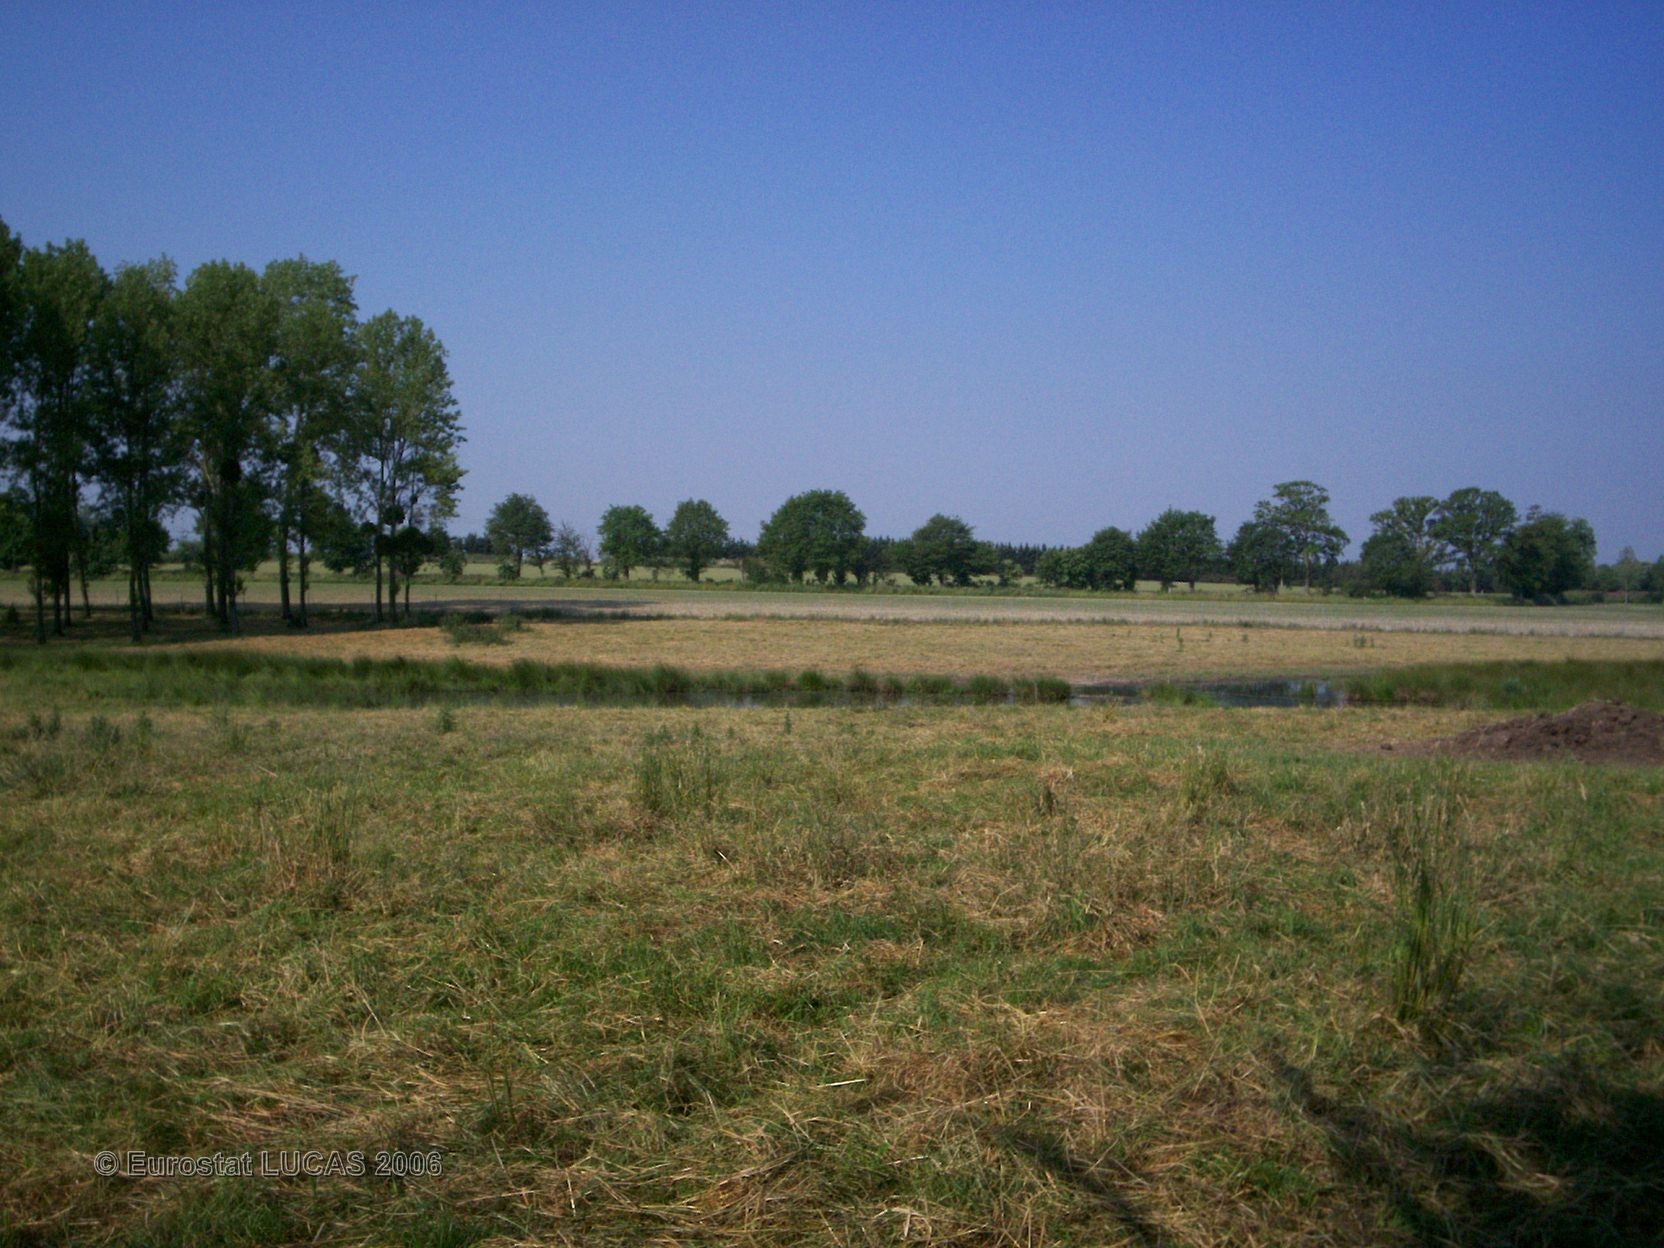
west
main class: Grassland
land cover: Grassland without tree/shrub cover
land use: Wetland
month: April
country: FR
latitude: 48.0378
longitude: -1.3228
